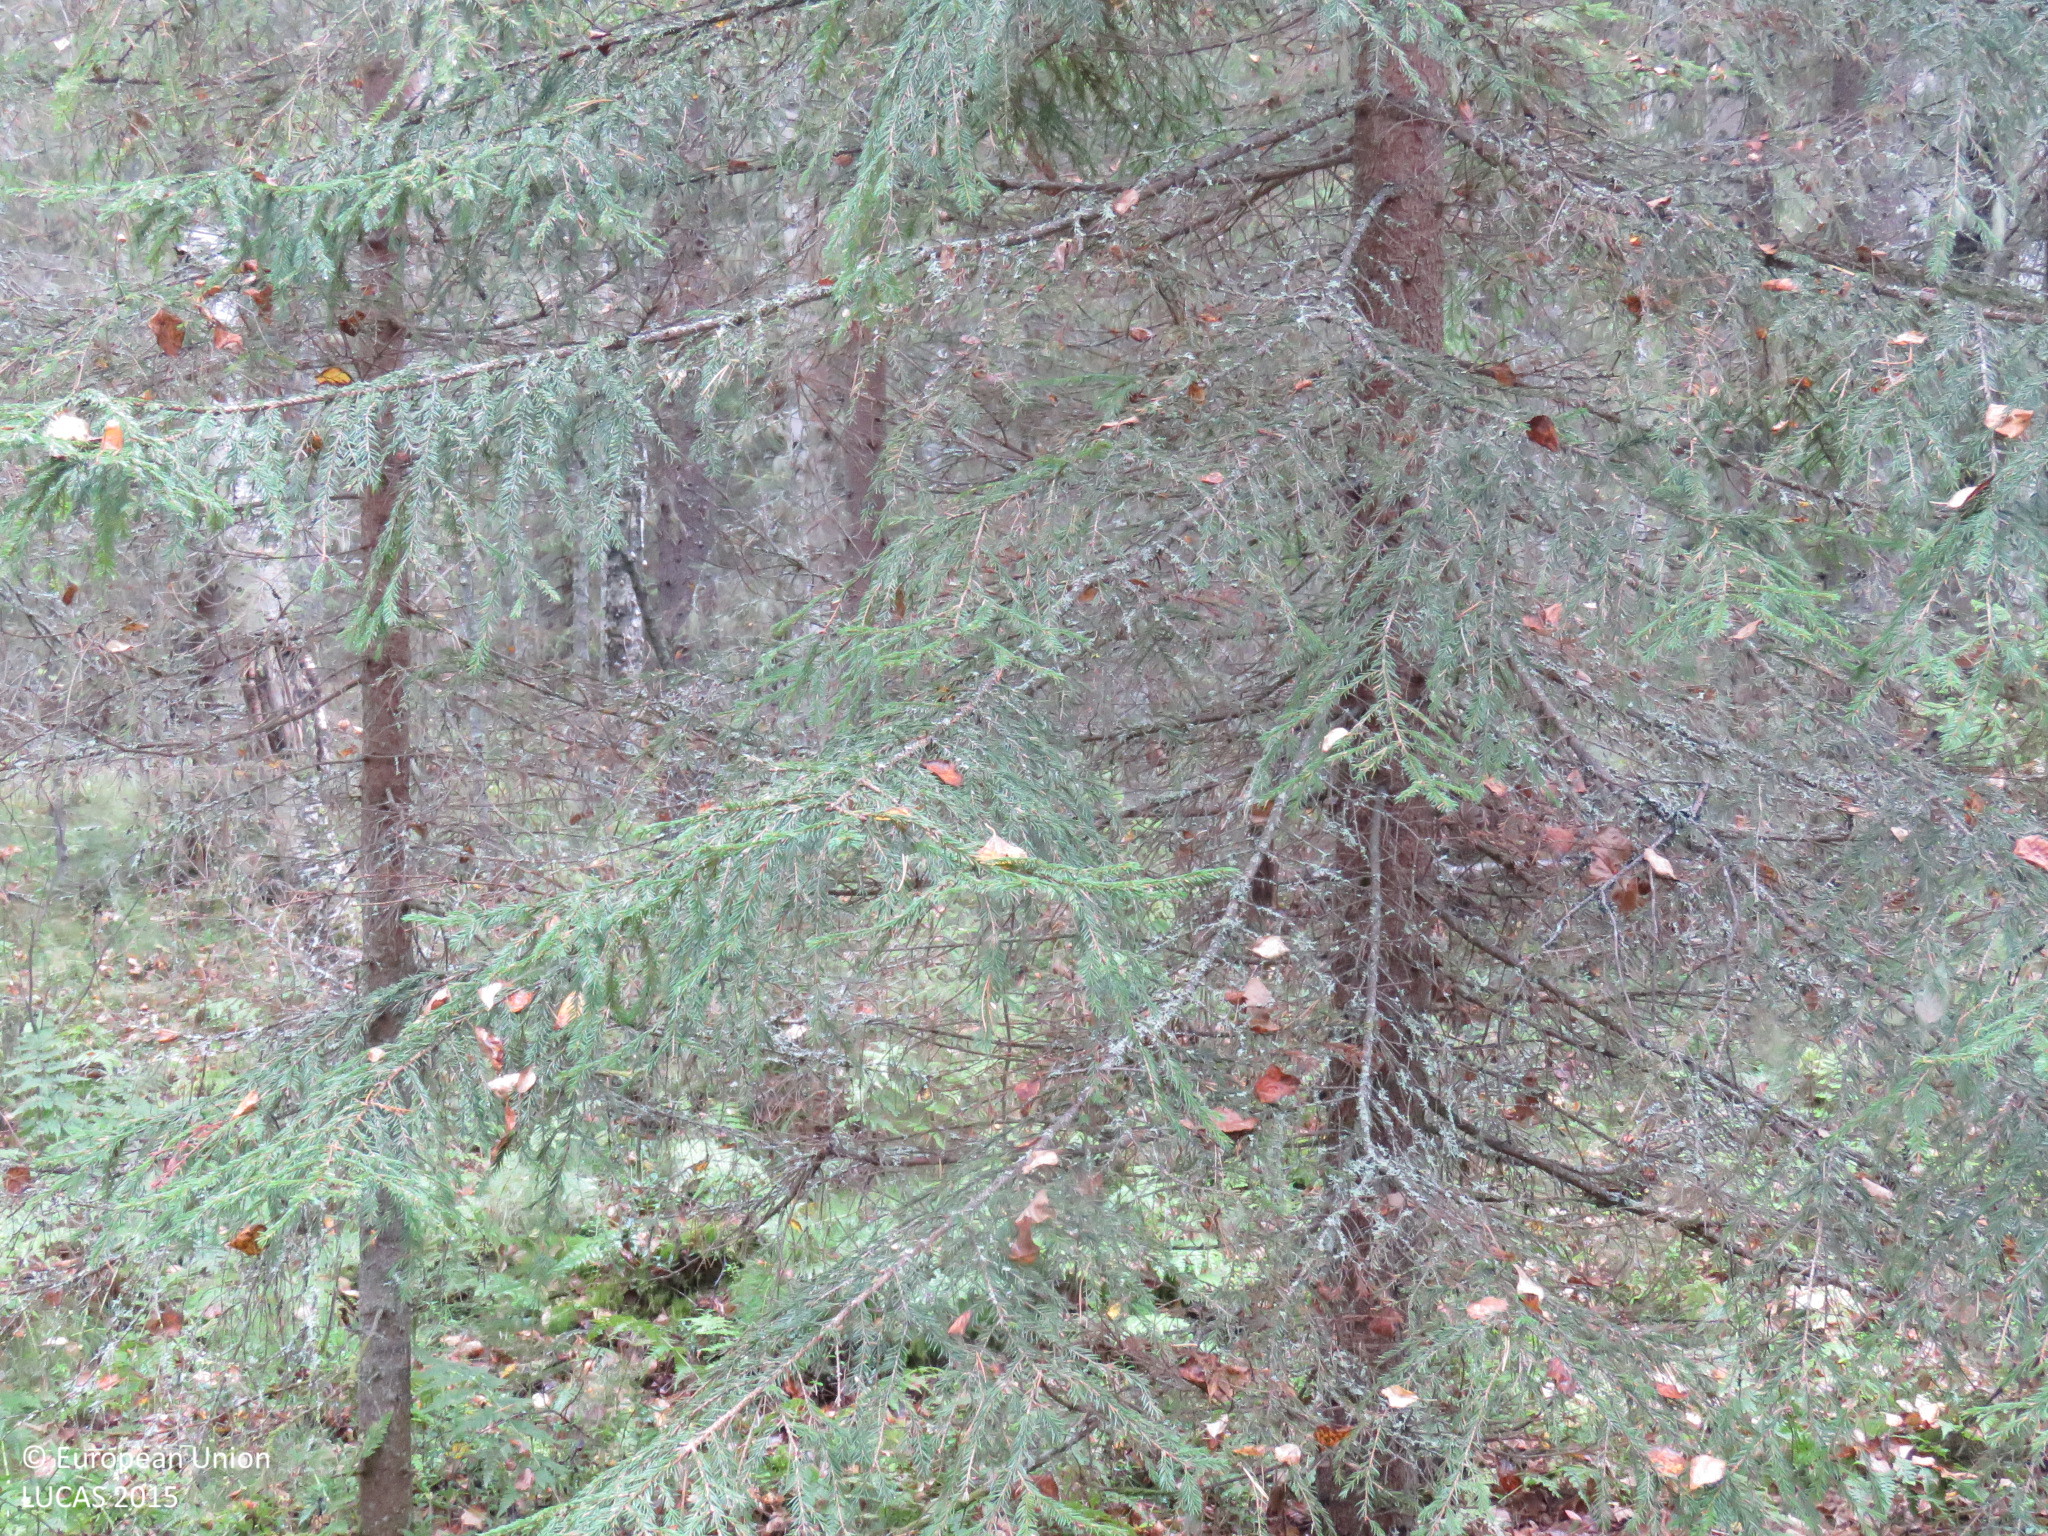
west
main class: Woodland
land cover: Other mixed woodland
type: boreal forest
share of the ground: > 75 %
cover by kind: coniferous forest trees 65 %, broadleaved forest trees 25 %, shrubs 5 %, herbaceous plants 5 %
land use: Forestry
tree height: > 5 m
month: September
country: FI
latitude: 64.8785
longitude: 26.6867
